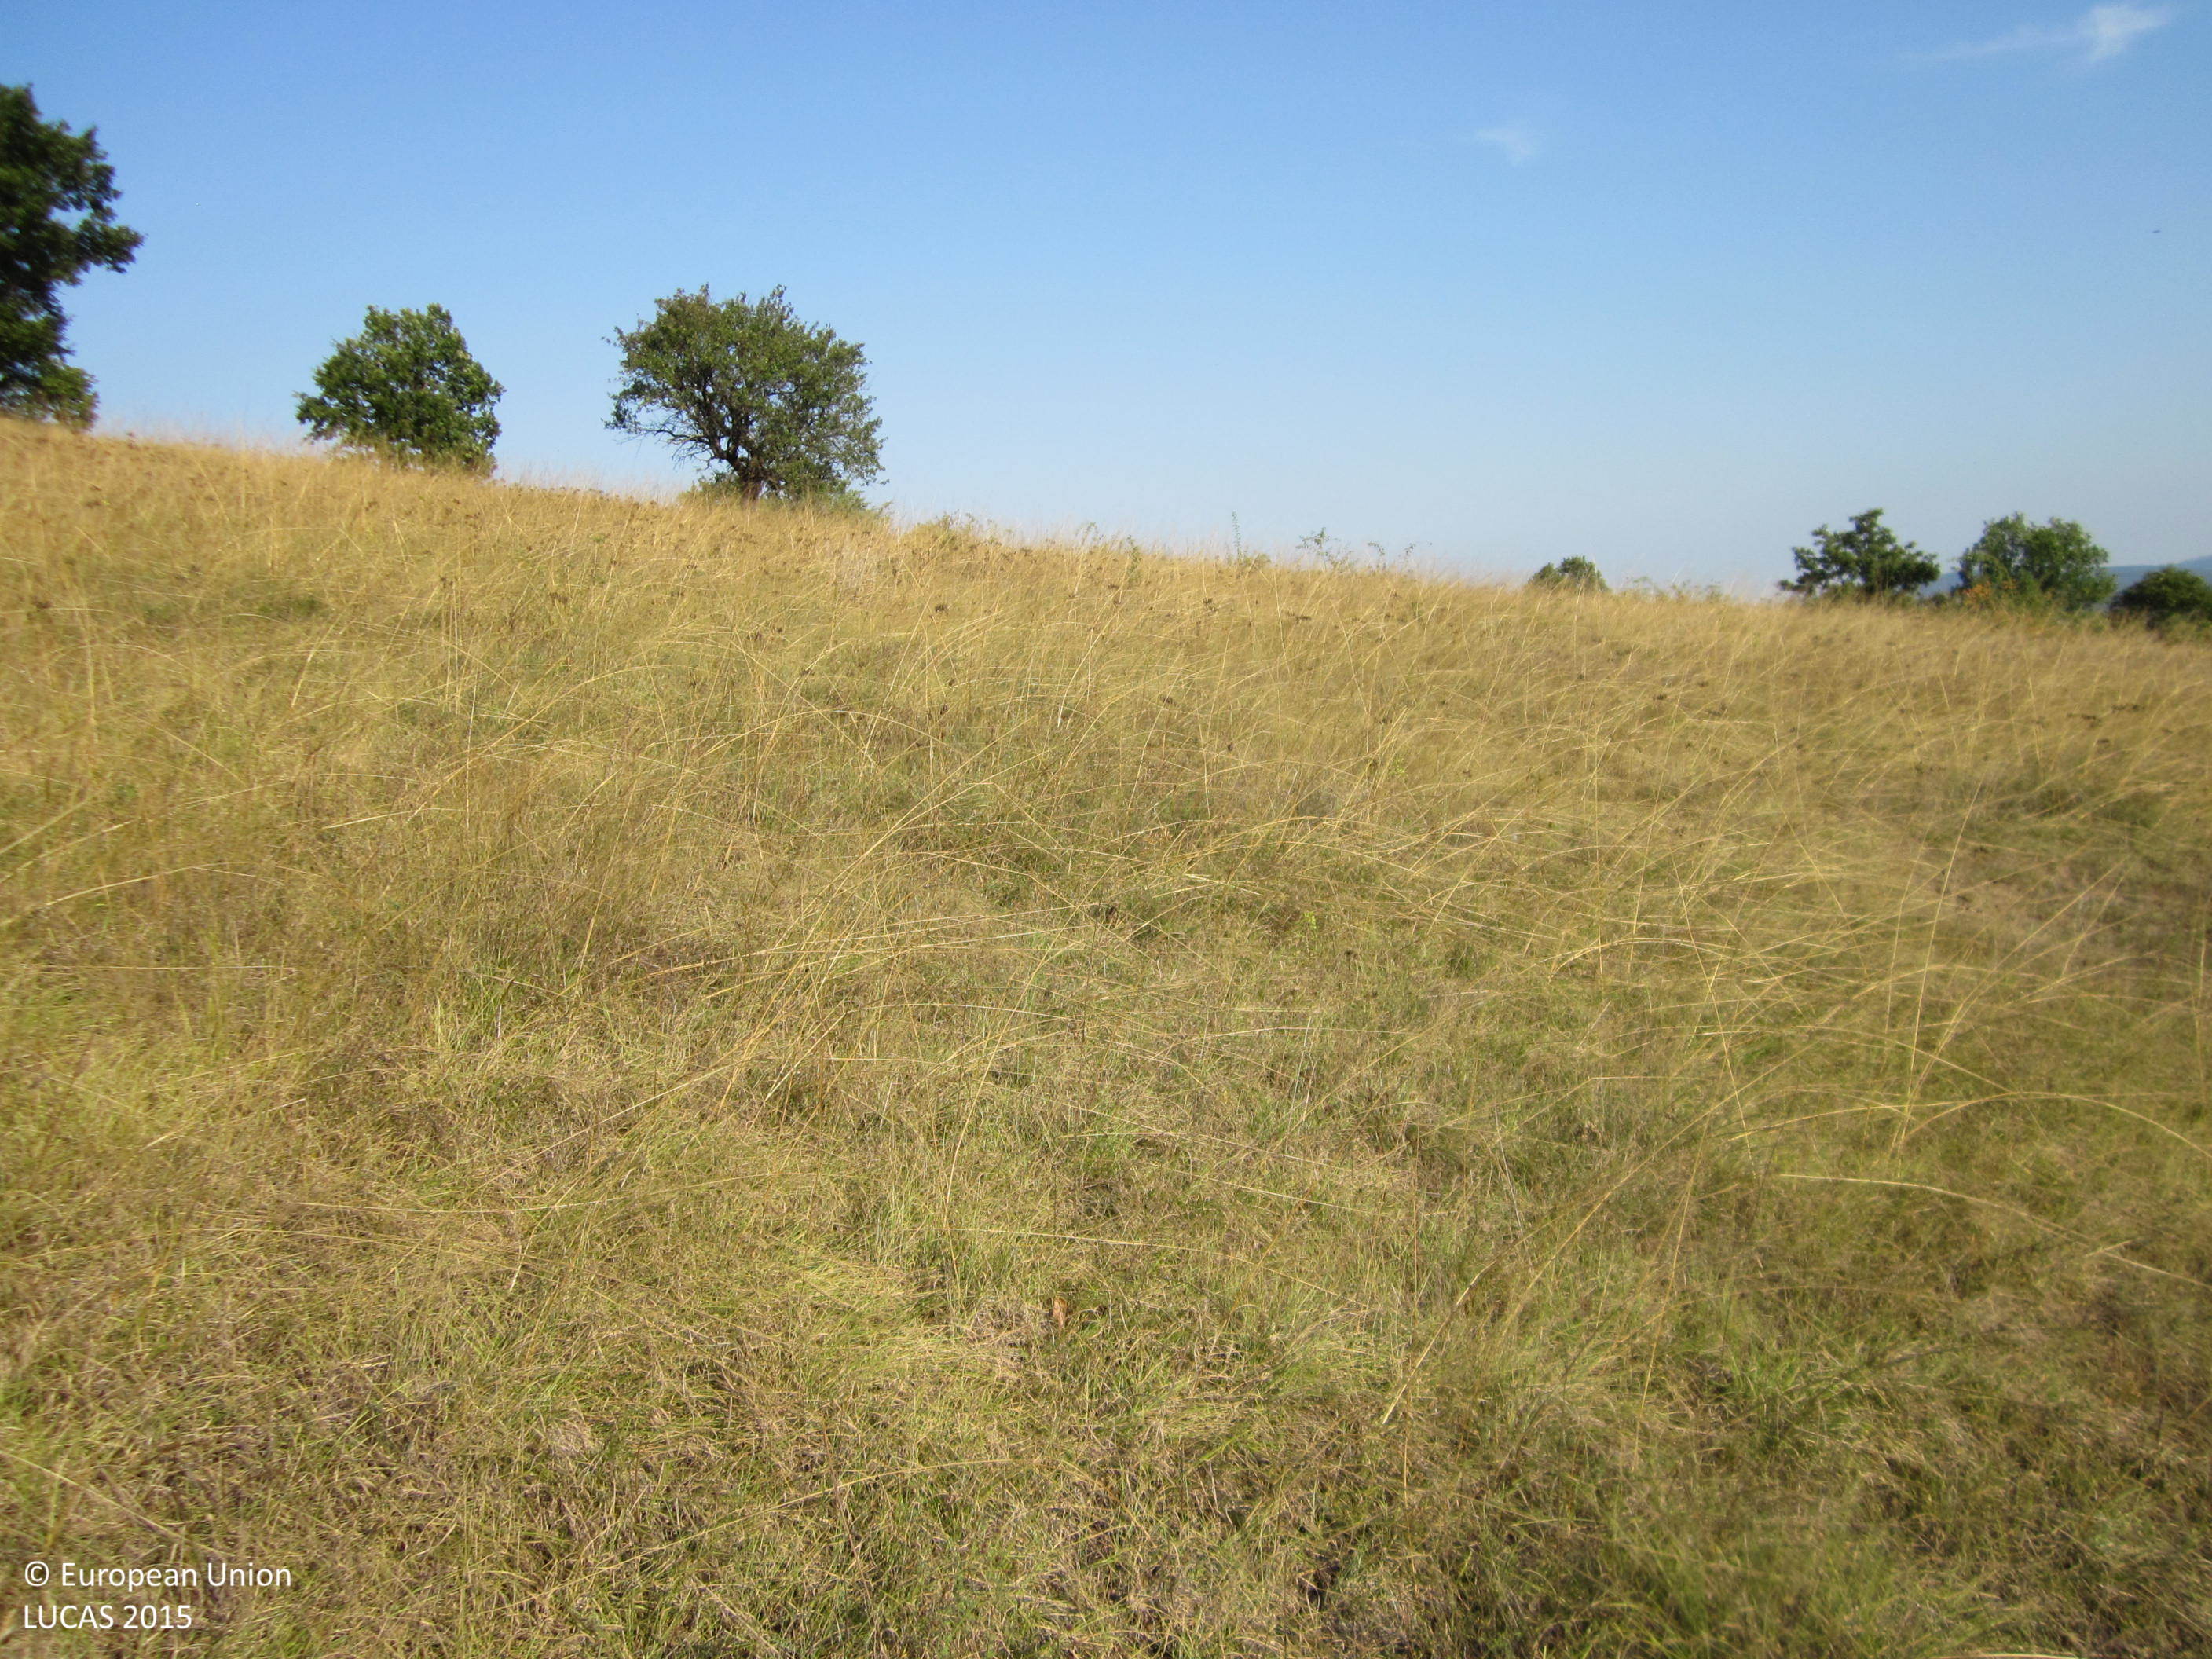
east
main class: Grassland
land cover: Grassland without tree/shrub cover
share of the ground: > 75 %
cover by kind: herbaceous plants 100 %
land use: Agriculture (excluding fallow land and kitchen gardens)
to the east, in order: Grassland without tree/shrub cover; Grassland with sparse tree/shrub cover; Grassland without tree/shrub cover; Grassland with sparse tree/shrub cover; Ditches and canals; Grassland with sparse tree/shrub cover; Ditches and canals; Grassland with sparse tree/shrub cover; Abandoned hedges; Grassland with sparse tree/shrub cover
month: September
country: BG
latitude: 42.8474
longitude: 27.0834
